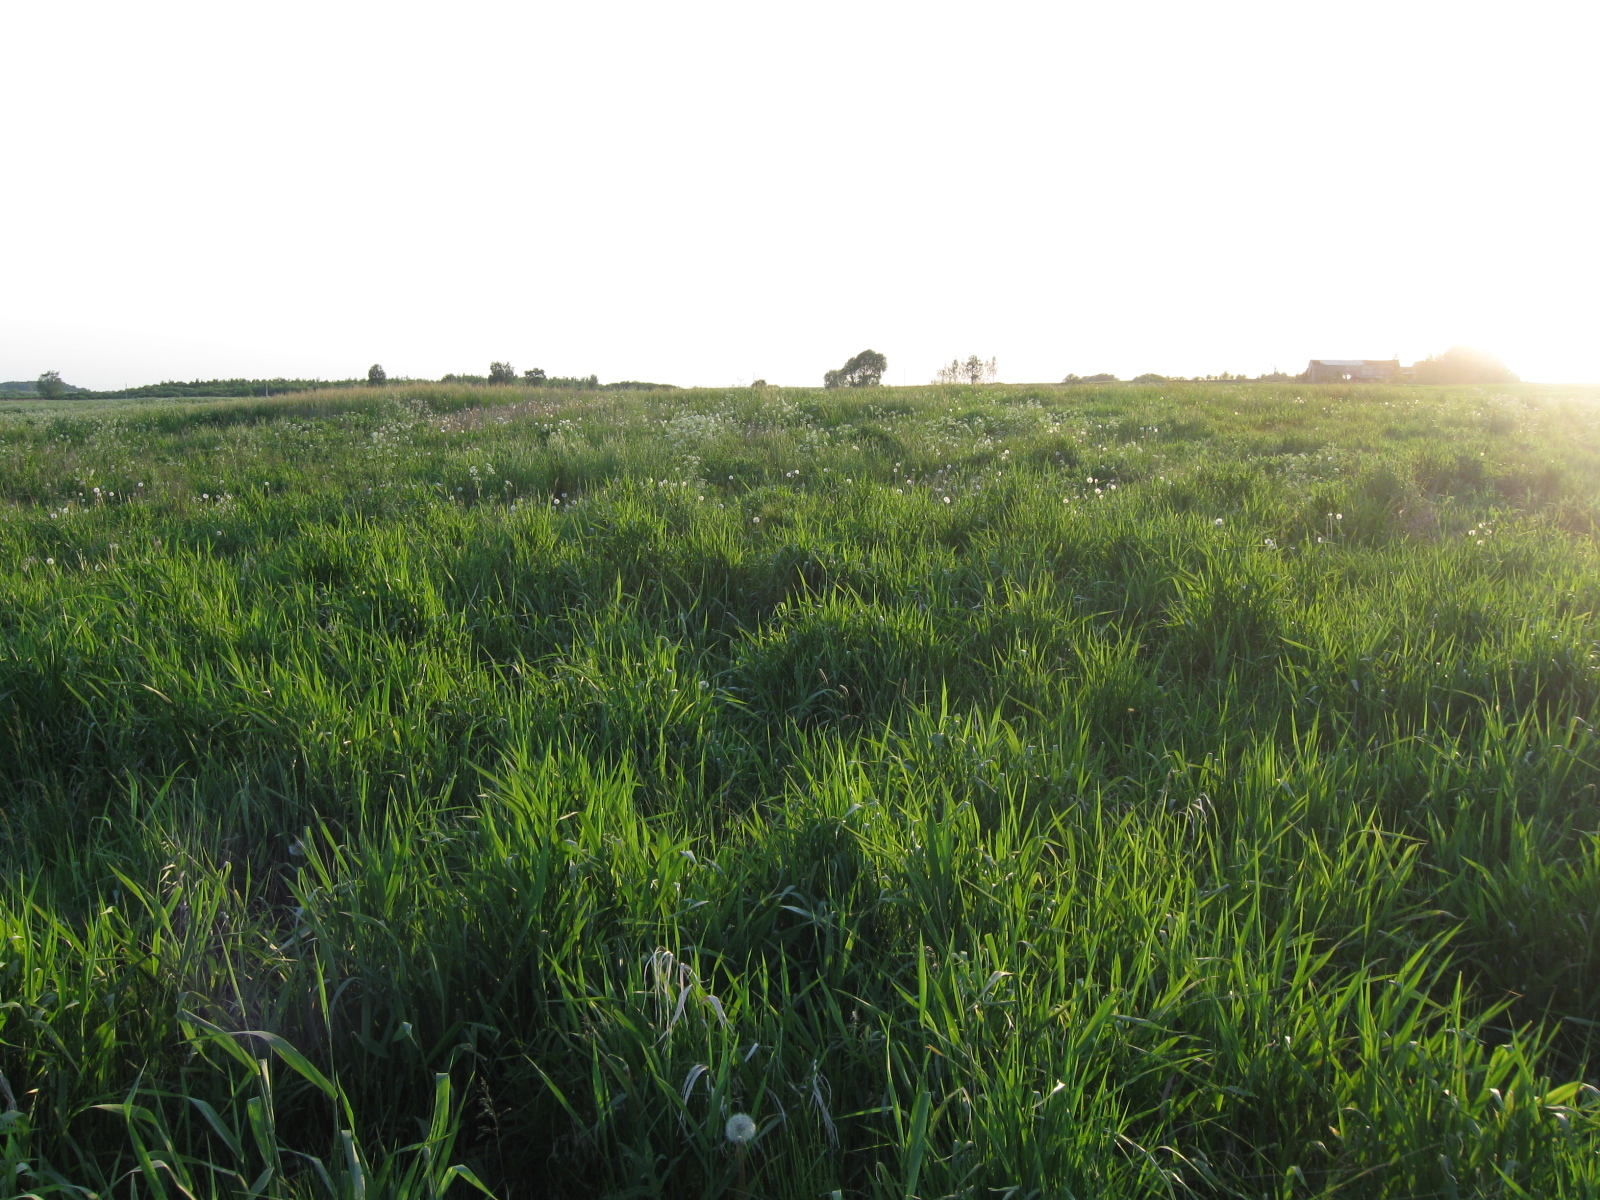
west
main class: Grassland
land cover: Grassland without tree/shrub cover
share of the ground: > 75 %
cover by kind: herbaceous plants 100 %
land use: Agriculture (excluding fallow land and kitchen gardens)
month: May
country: LT
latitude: 54.5596
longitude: 22.7955
